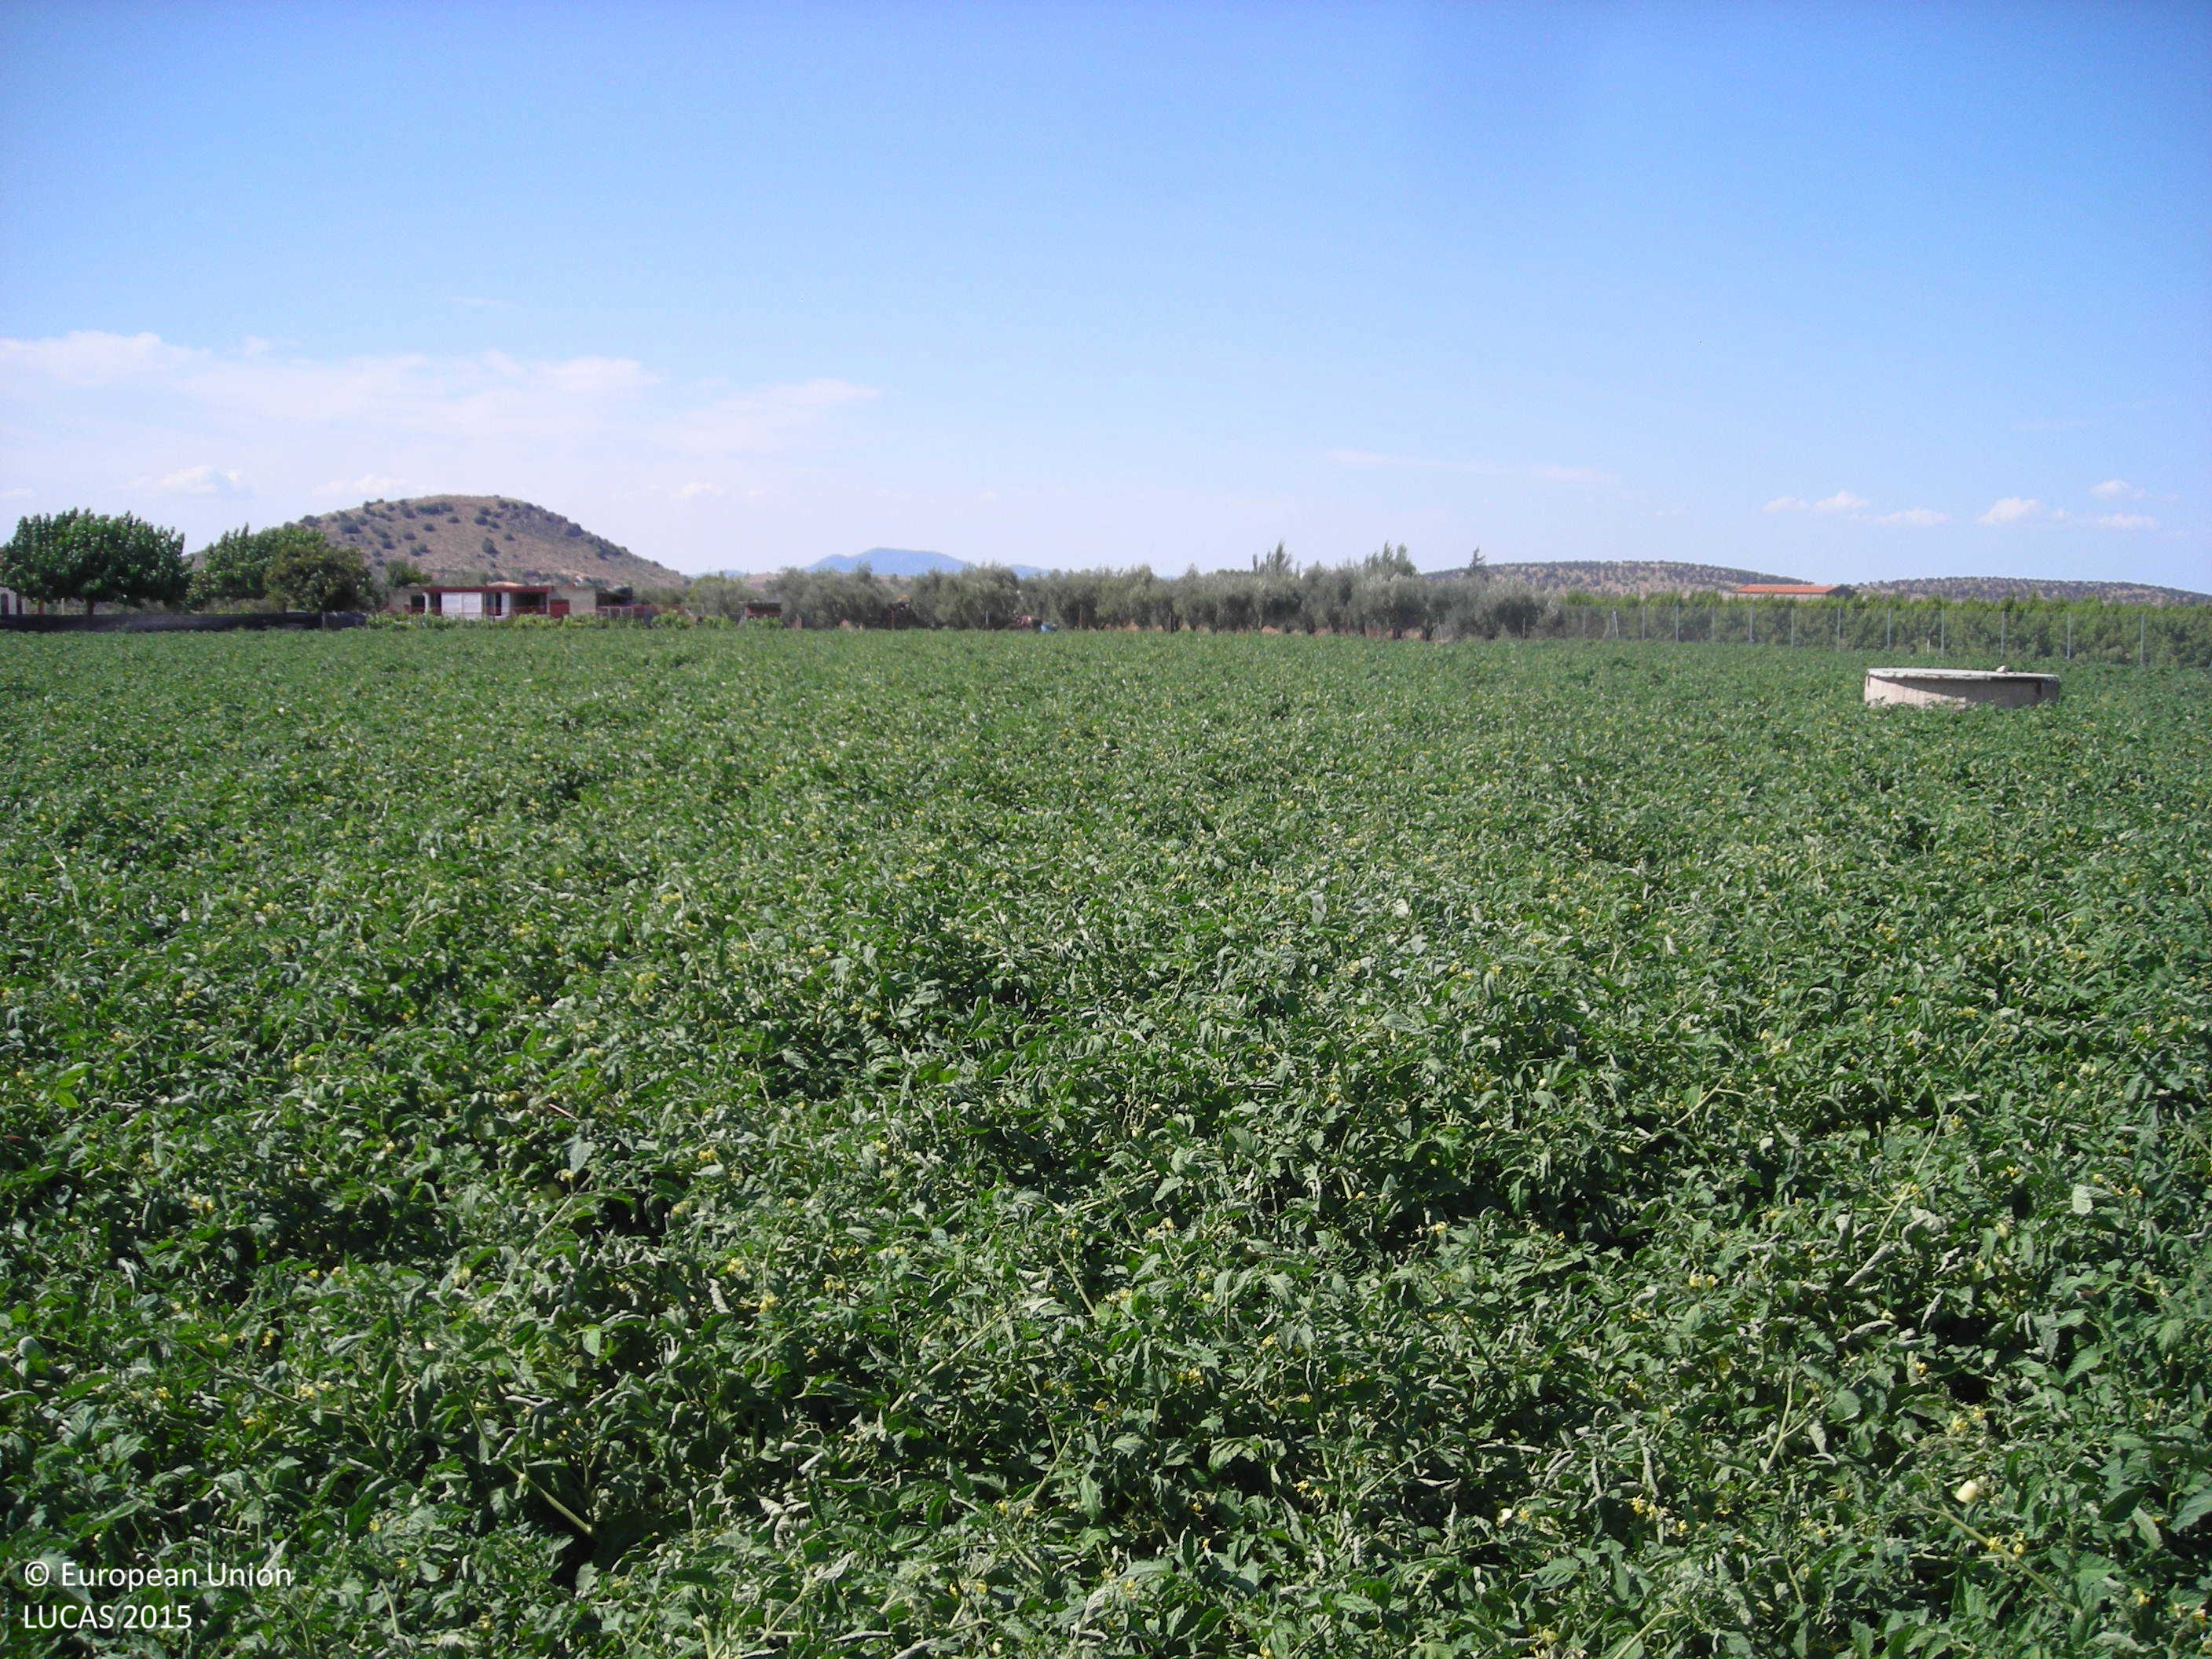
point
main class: Cropland
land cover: Tomatoes
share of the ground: > 75 %
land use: Agriculture (excluding fallow land and kitchen gardens)
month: July
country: ES
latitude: 38.9546
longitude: -5.9404
